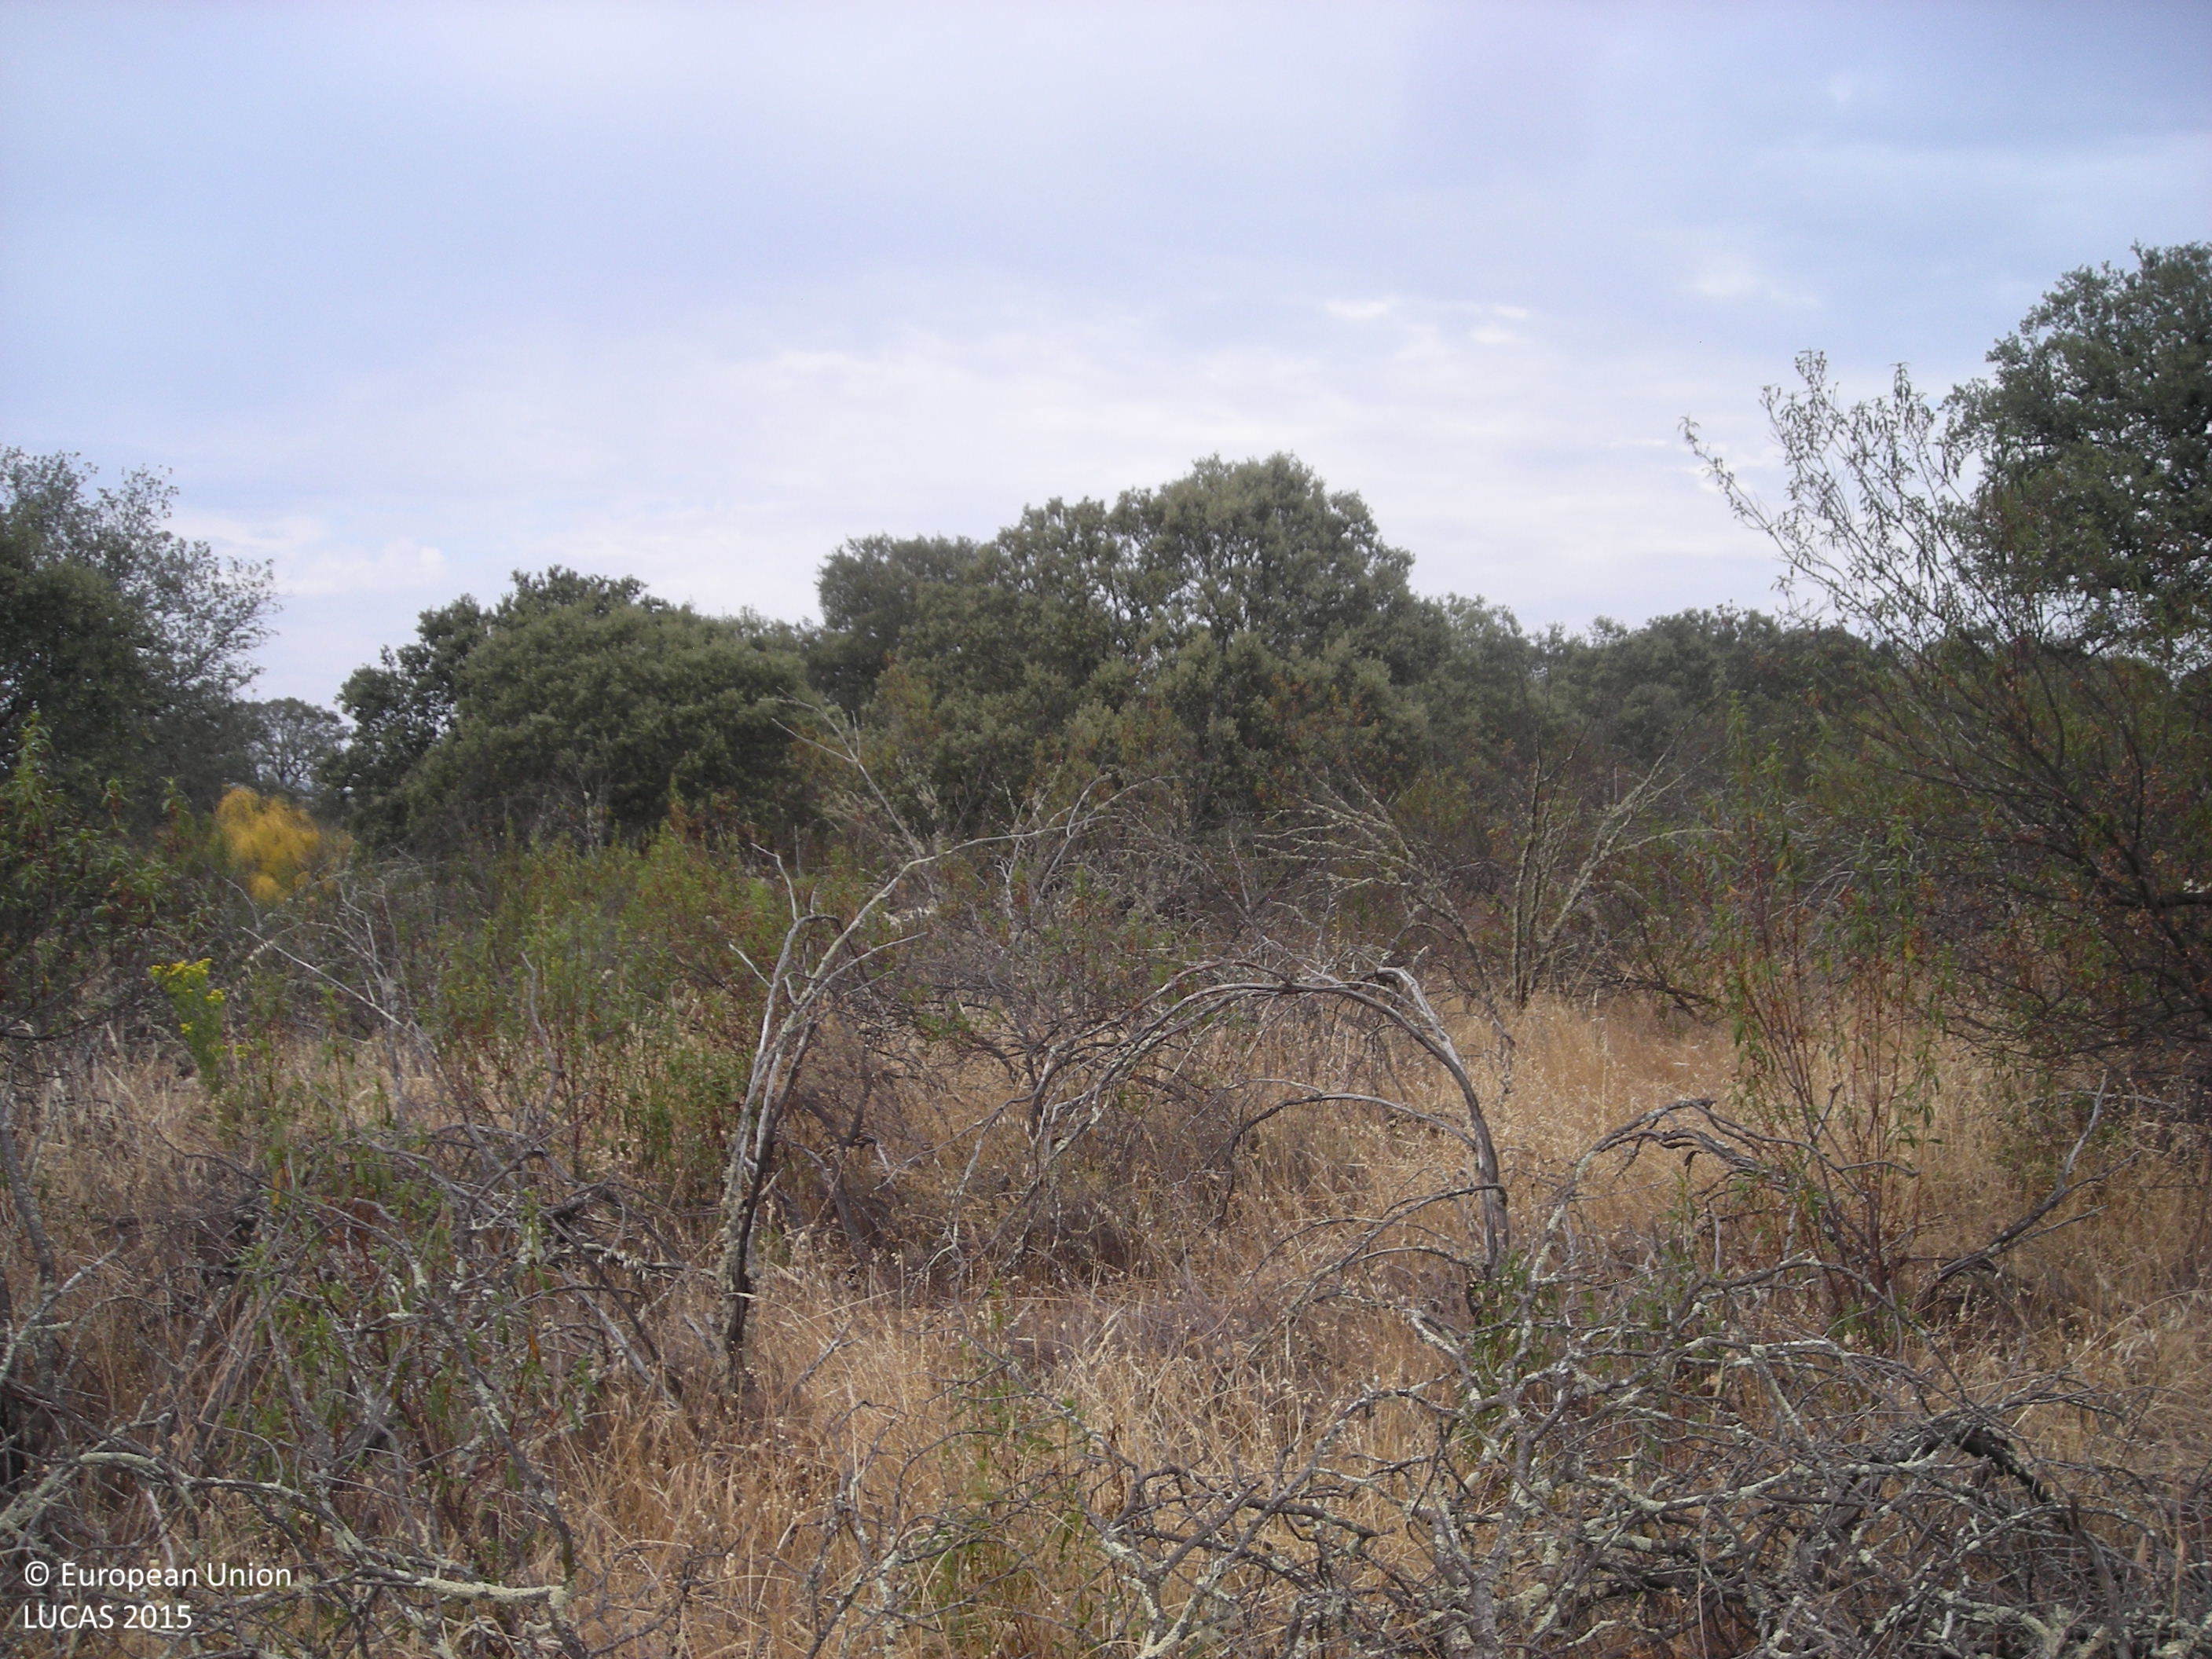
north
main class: Woodland
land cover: Broadleaved woodland
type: broadleaved evergreen forest
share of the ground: 25 - 50 %
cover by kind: shrubs 60 %, broadleaved forest trees 40 %
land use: Semi-natural and natural areas not in use
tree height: > 5 m
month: July
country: ES
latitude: 39.2347
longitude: -5.4668
